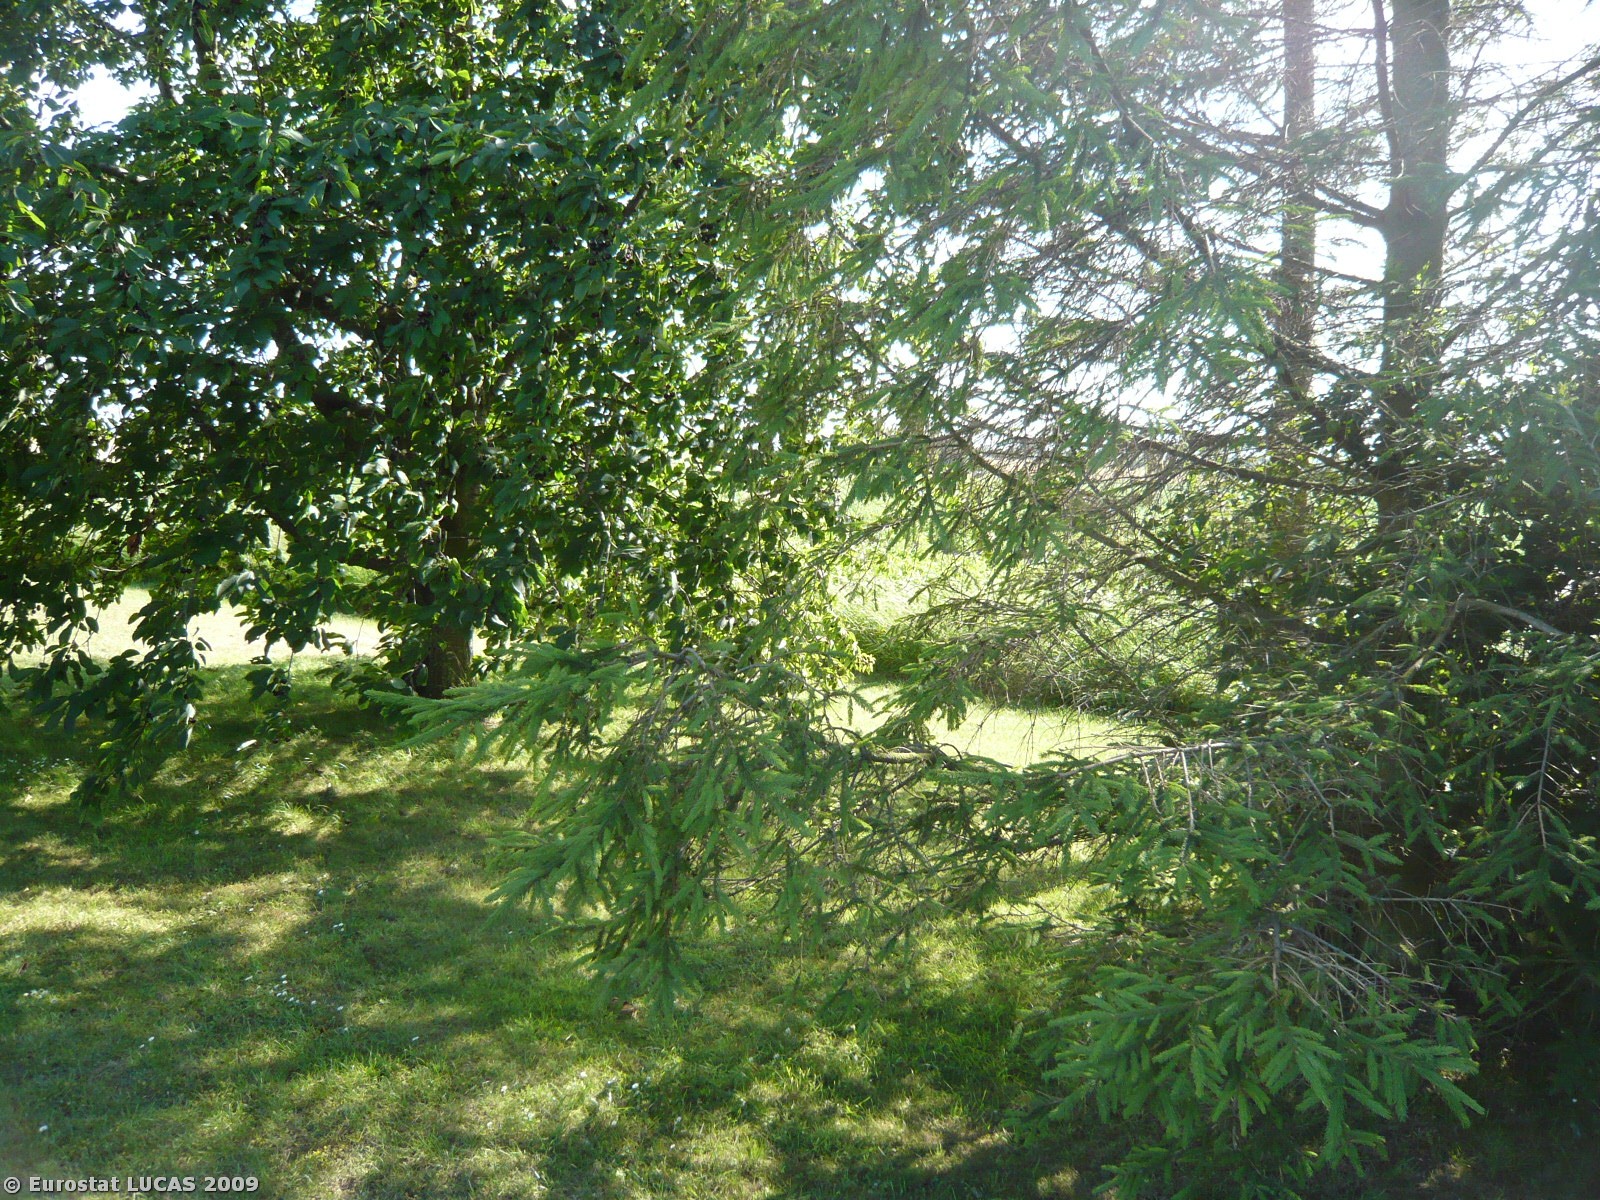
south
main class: Grassland
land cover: Grassland without tree/shrub cover
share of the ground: > 75 %
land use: Residential
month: July
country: DK
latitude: 55.7462
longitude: 11.6074
